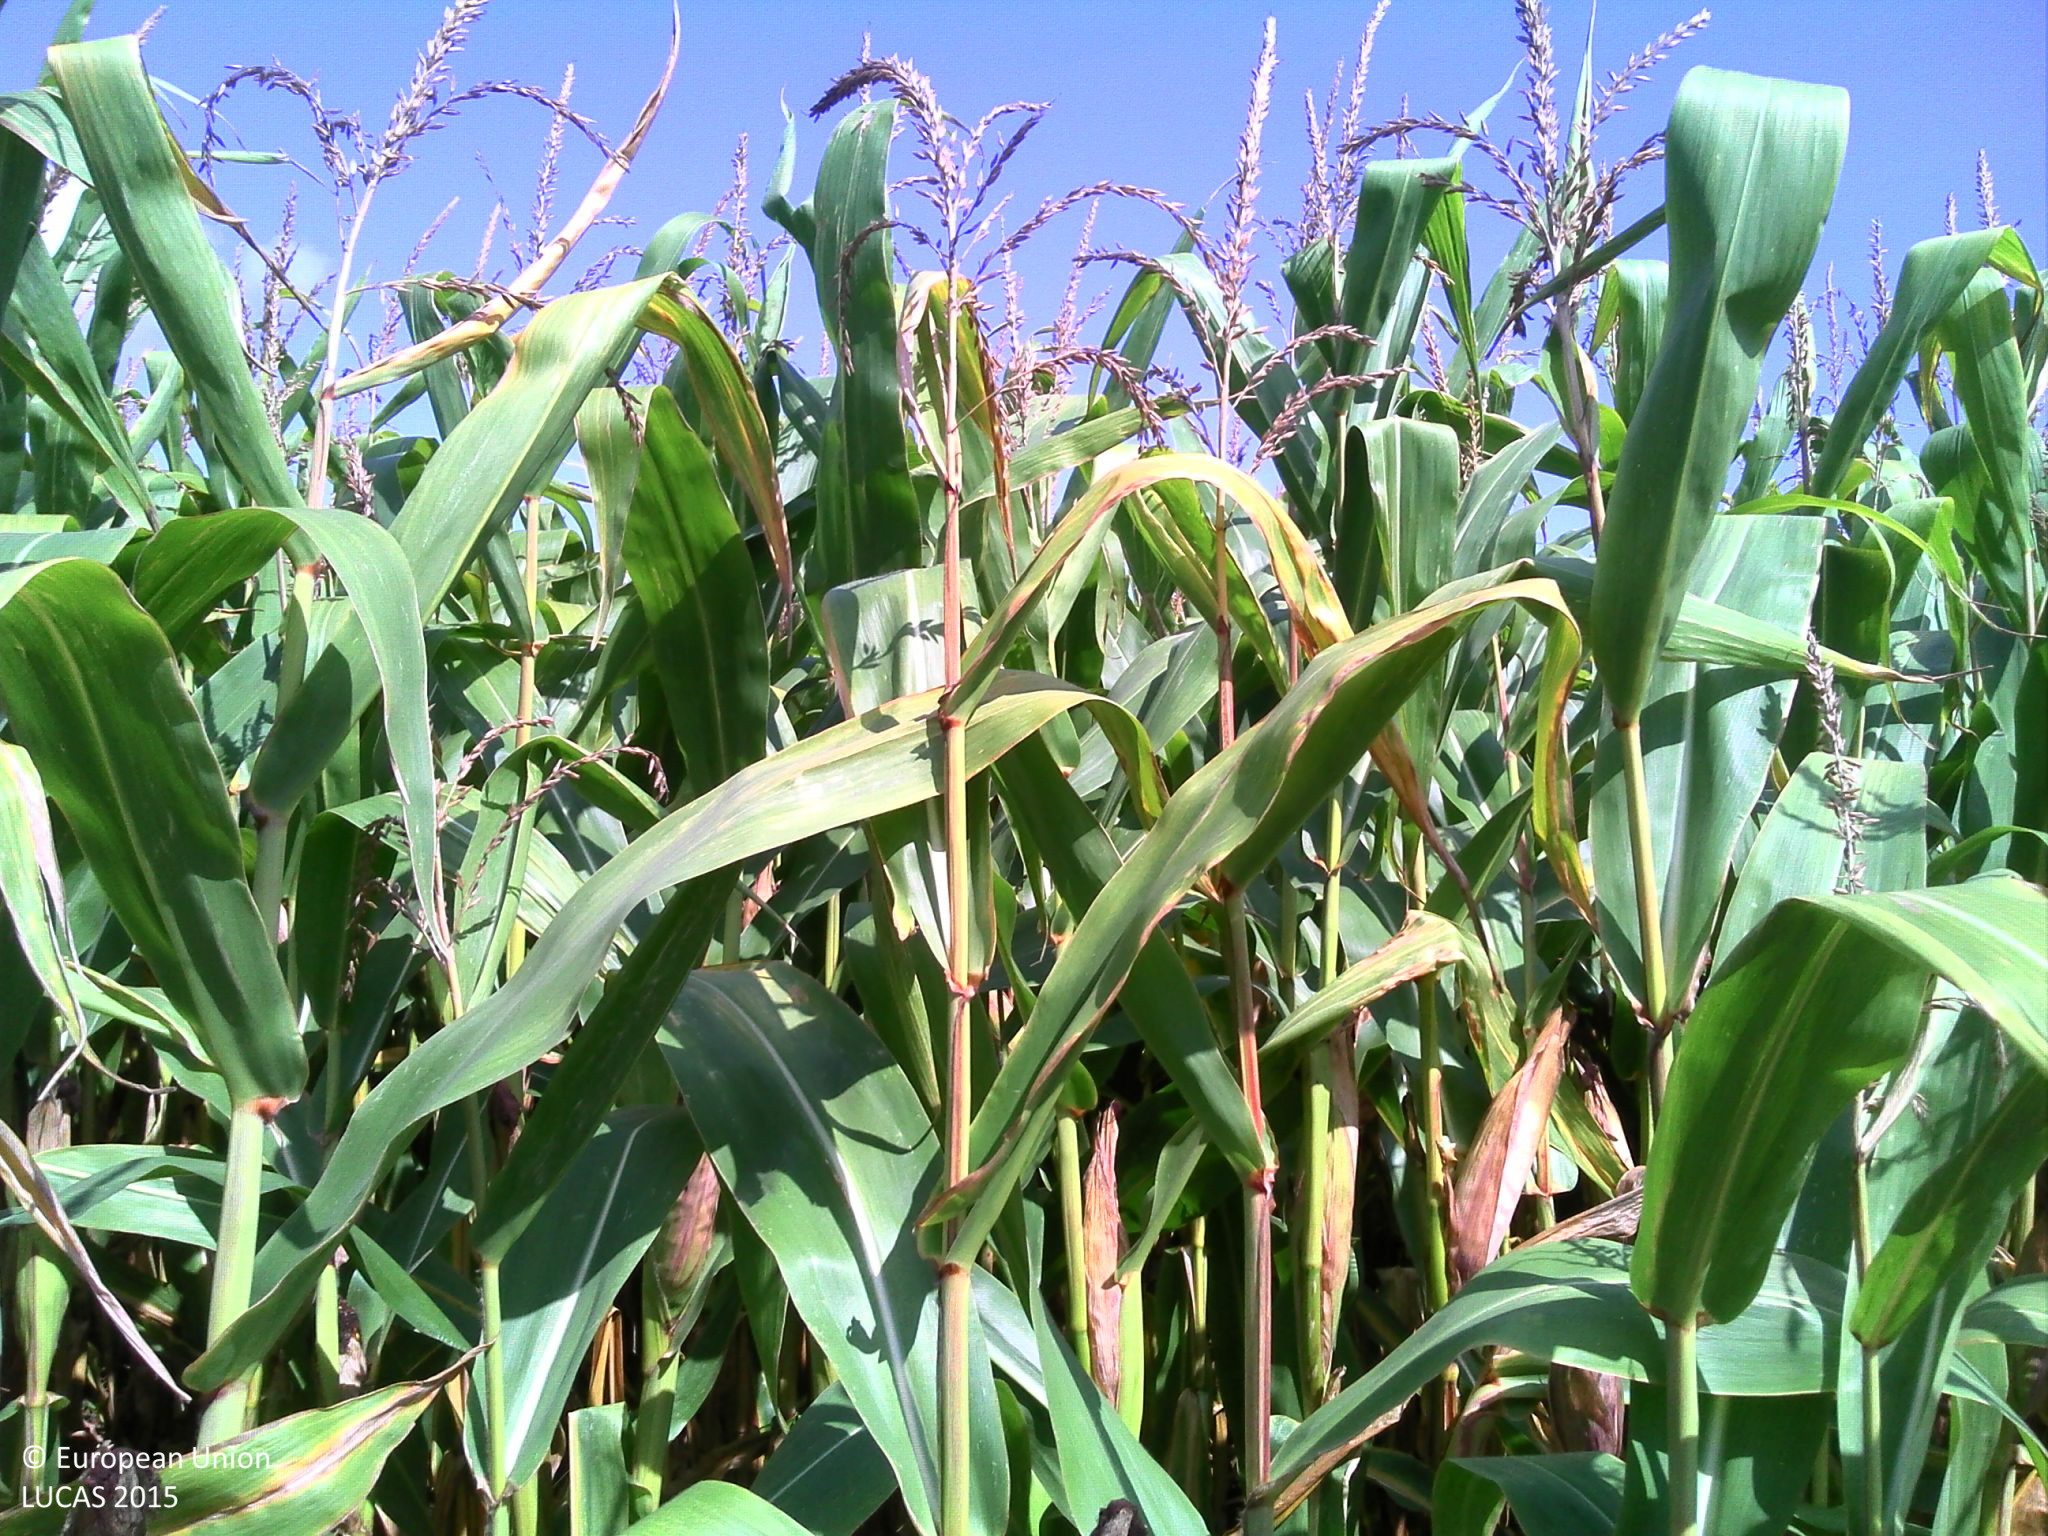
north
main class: Cropland
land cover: Maize
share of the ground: > 75 %
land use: Agriculture (excluding fallow land and kitchen gardens)
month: August
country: FR
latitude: 48.7745
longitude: 7.6466
